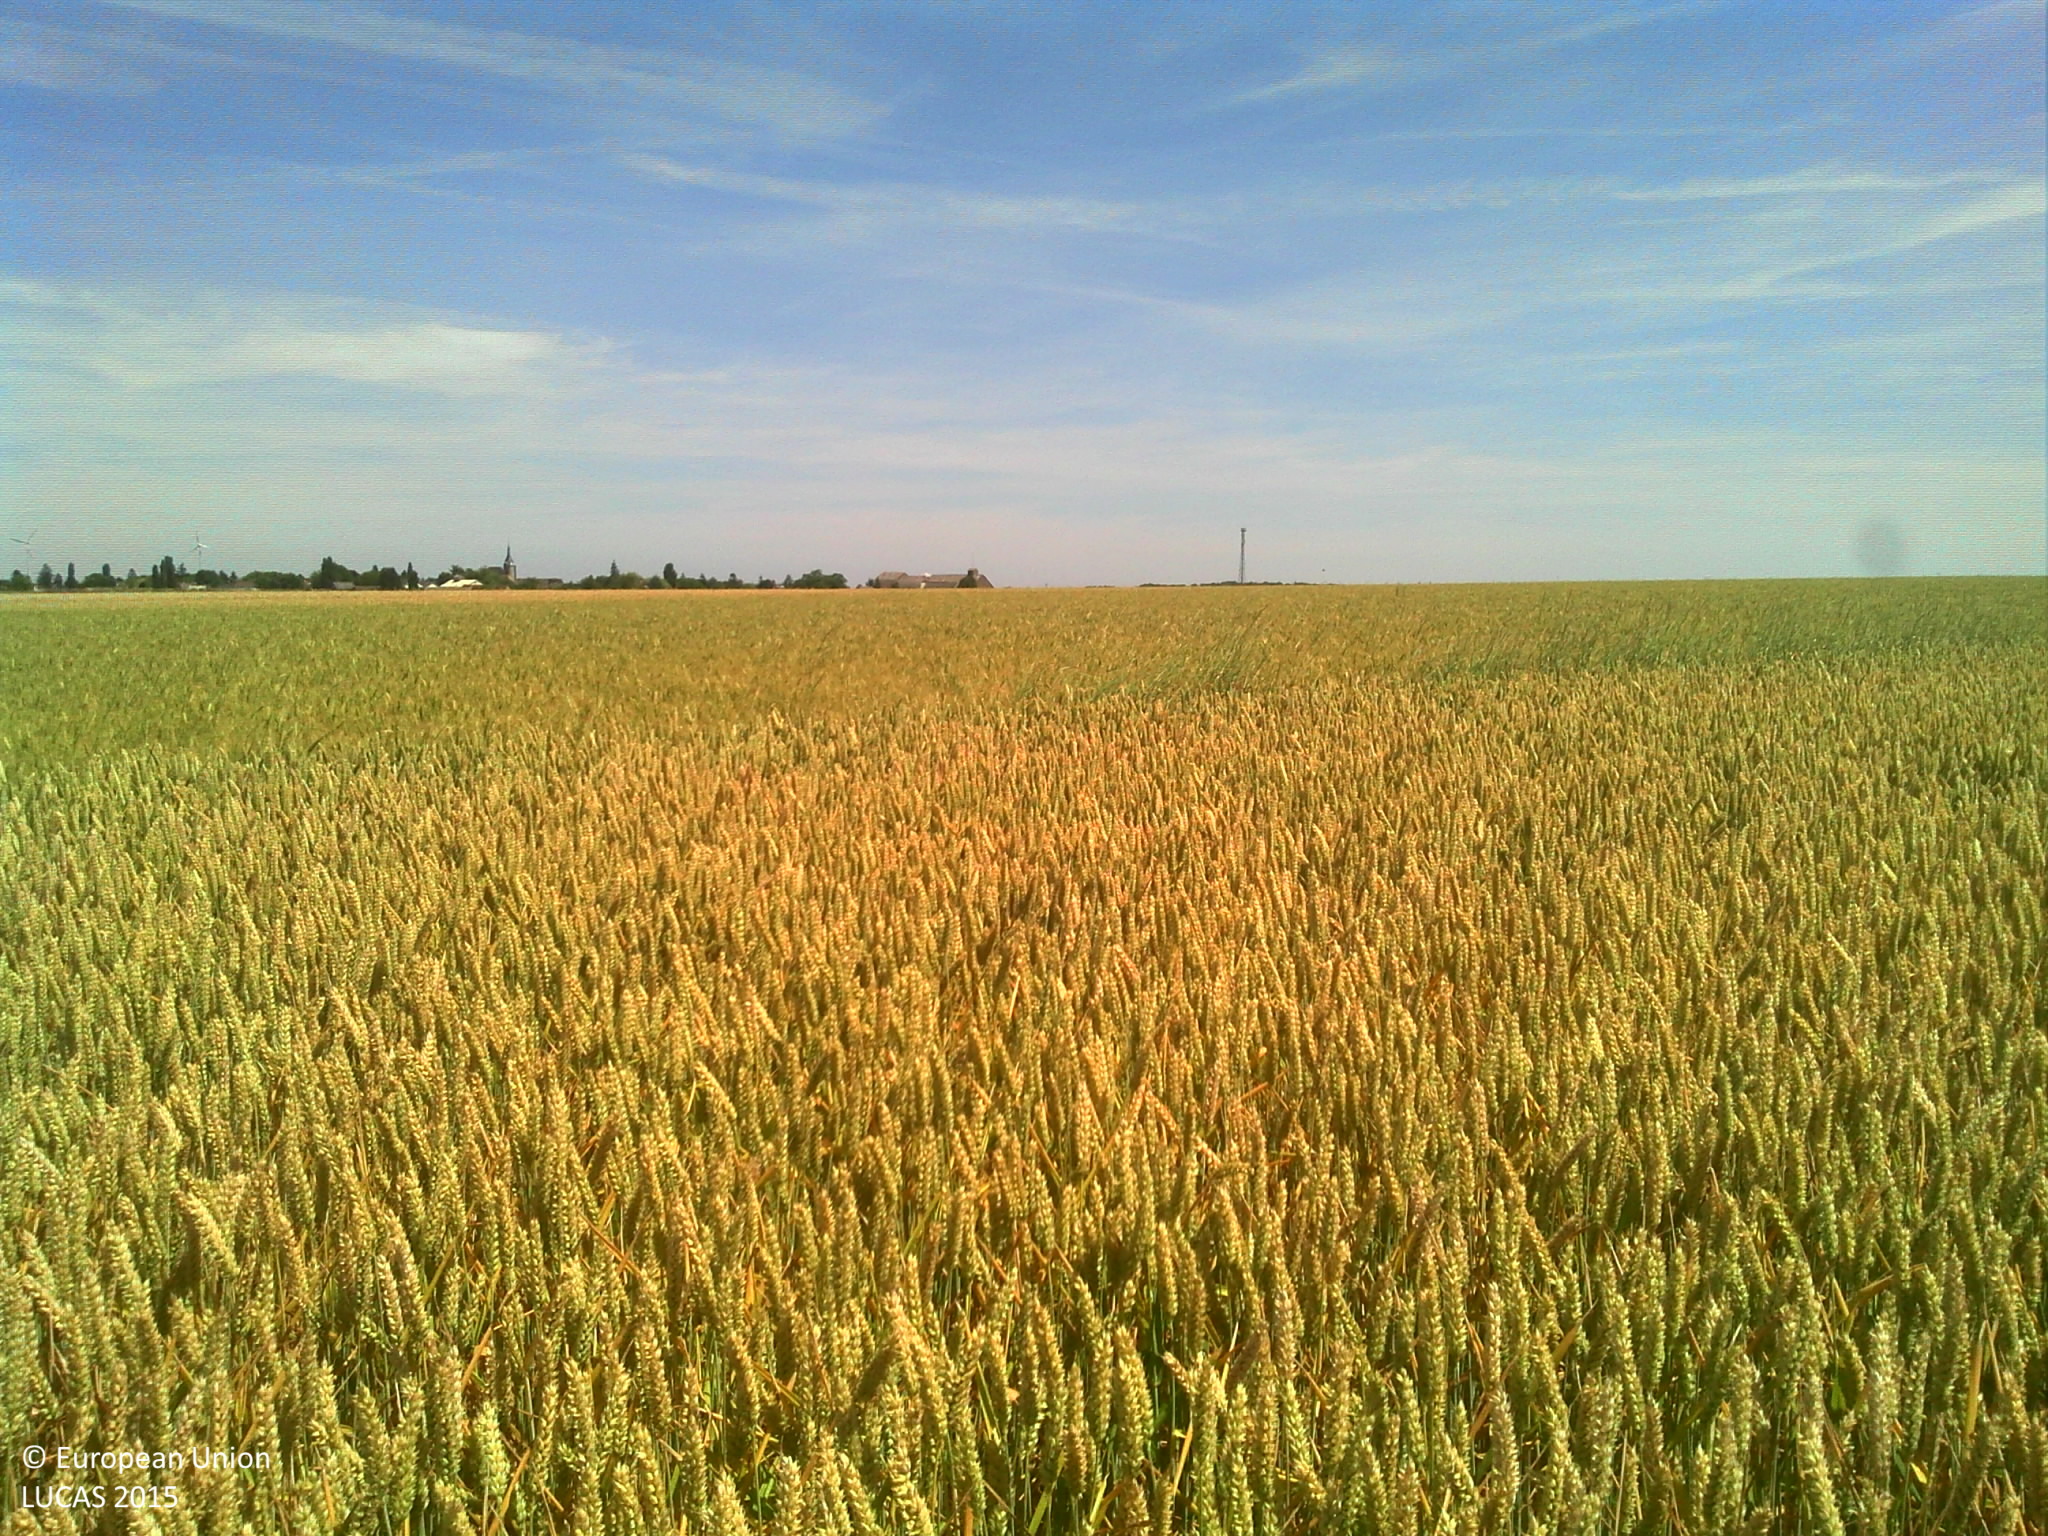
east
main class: Cropland
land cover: Common wheat
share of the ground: > 75 %
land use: Agriculture (excluding fallow land and kitchen gardens)
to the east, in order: Common wheat
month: June
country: FR
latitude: 48.6462
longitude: 1.3905
